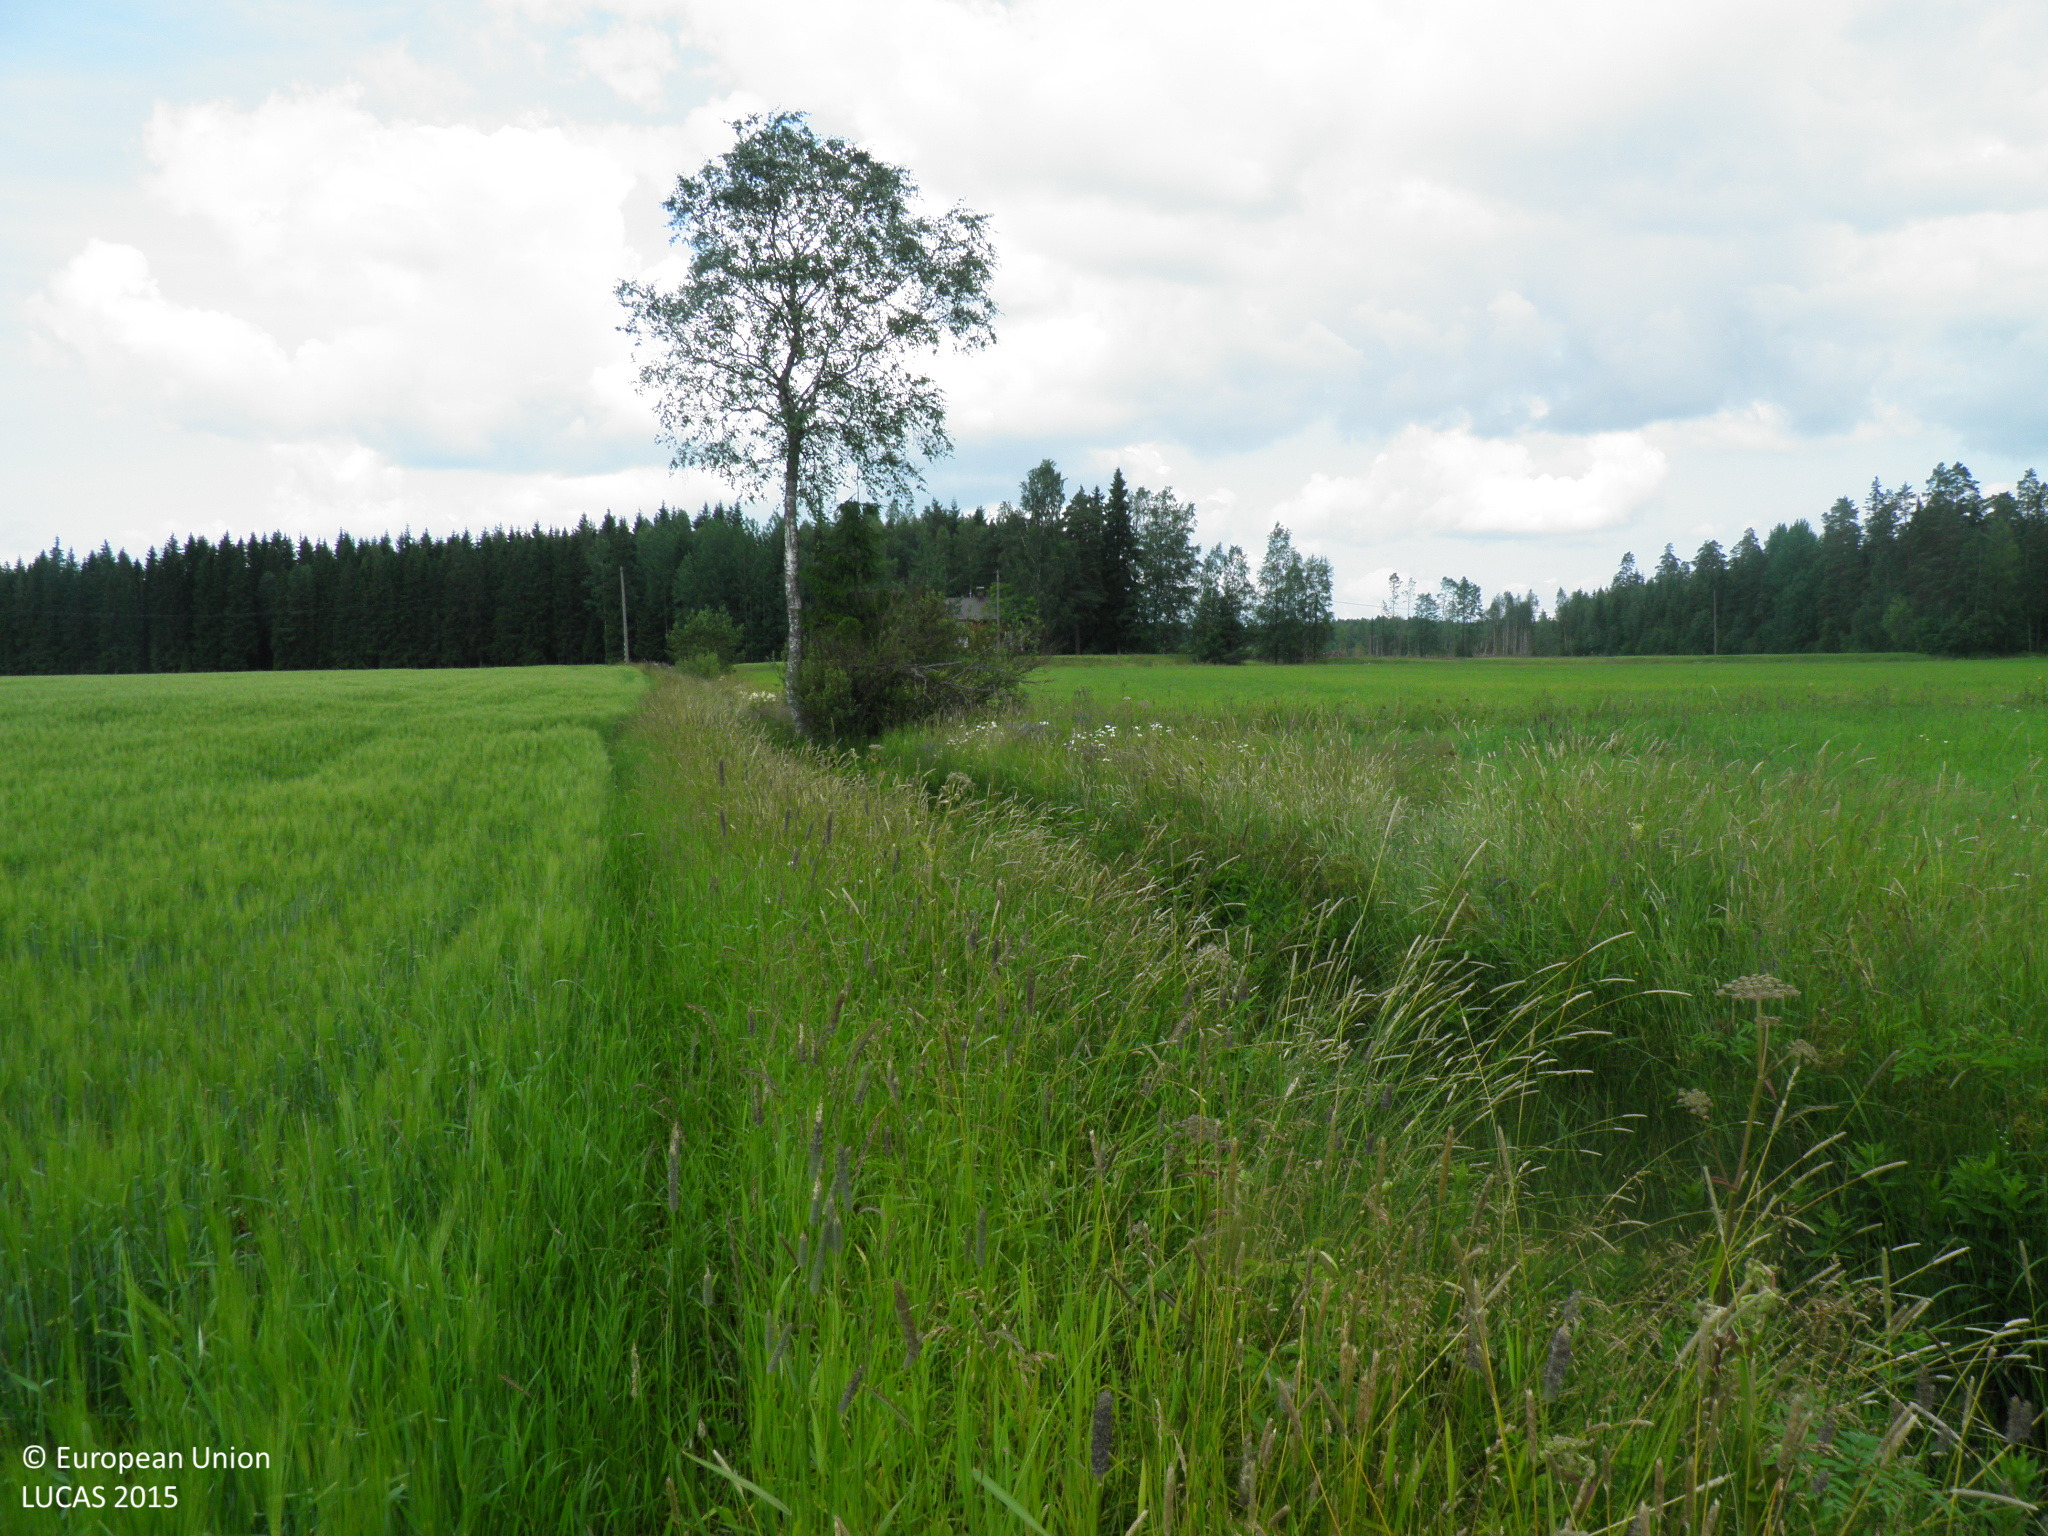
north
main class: Cropland
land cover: Barley
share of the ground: > 75 %
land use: Agriculture (excluding fallow land and kitchen gardens)
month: July
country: FI
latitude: 60.6553
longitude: 22.3787
